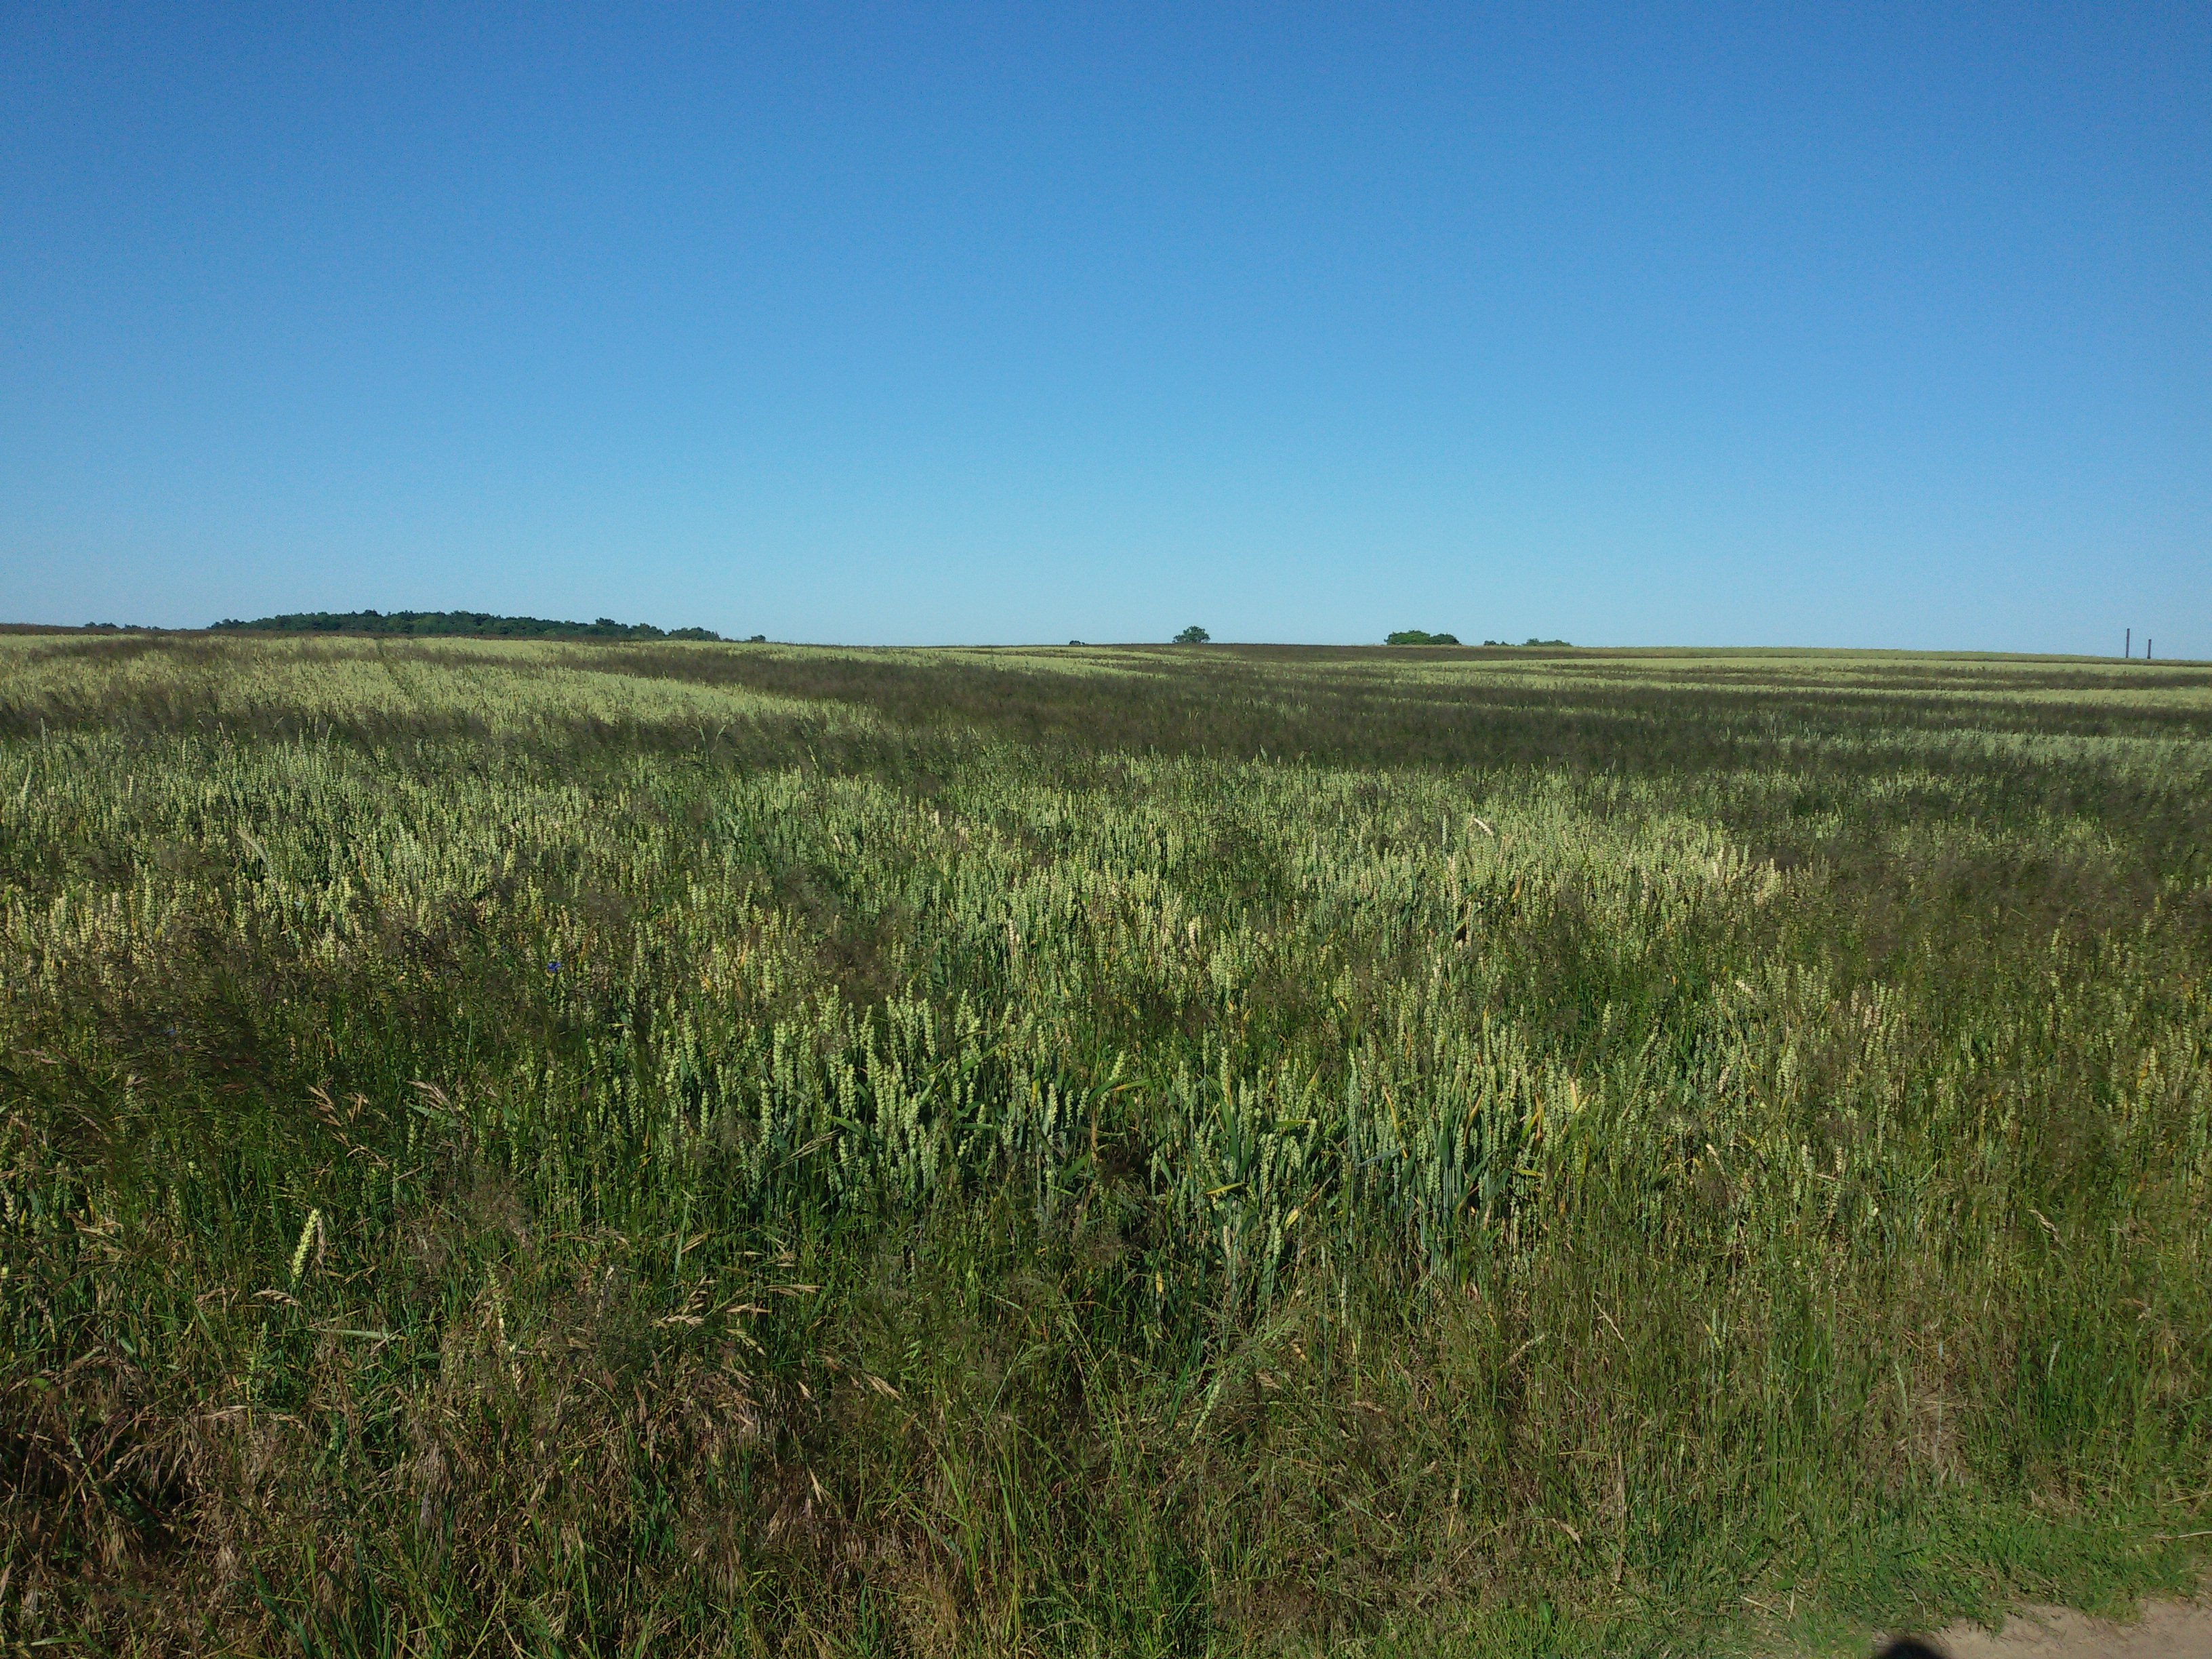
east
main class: Cropland
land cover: Common wheat
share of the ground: > 75 %
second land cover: Spontaneously vegetated surfaces
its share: 10 - 25 %
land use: Agriculture (excluding fallow land and kitchen gardens)
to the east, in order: Grass margins; Tracks; Grass margins; Common wheat; Rape and turnip rape
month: July
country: PL
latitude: 53.0655
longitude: 14.5231
